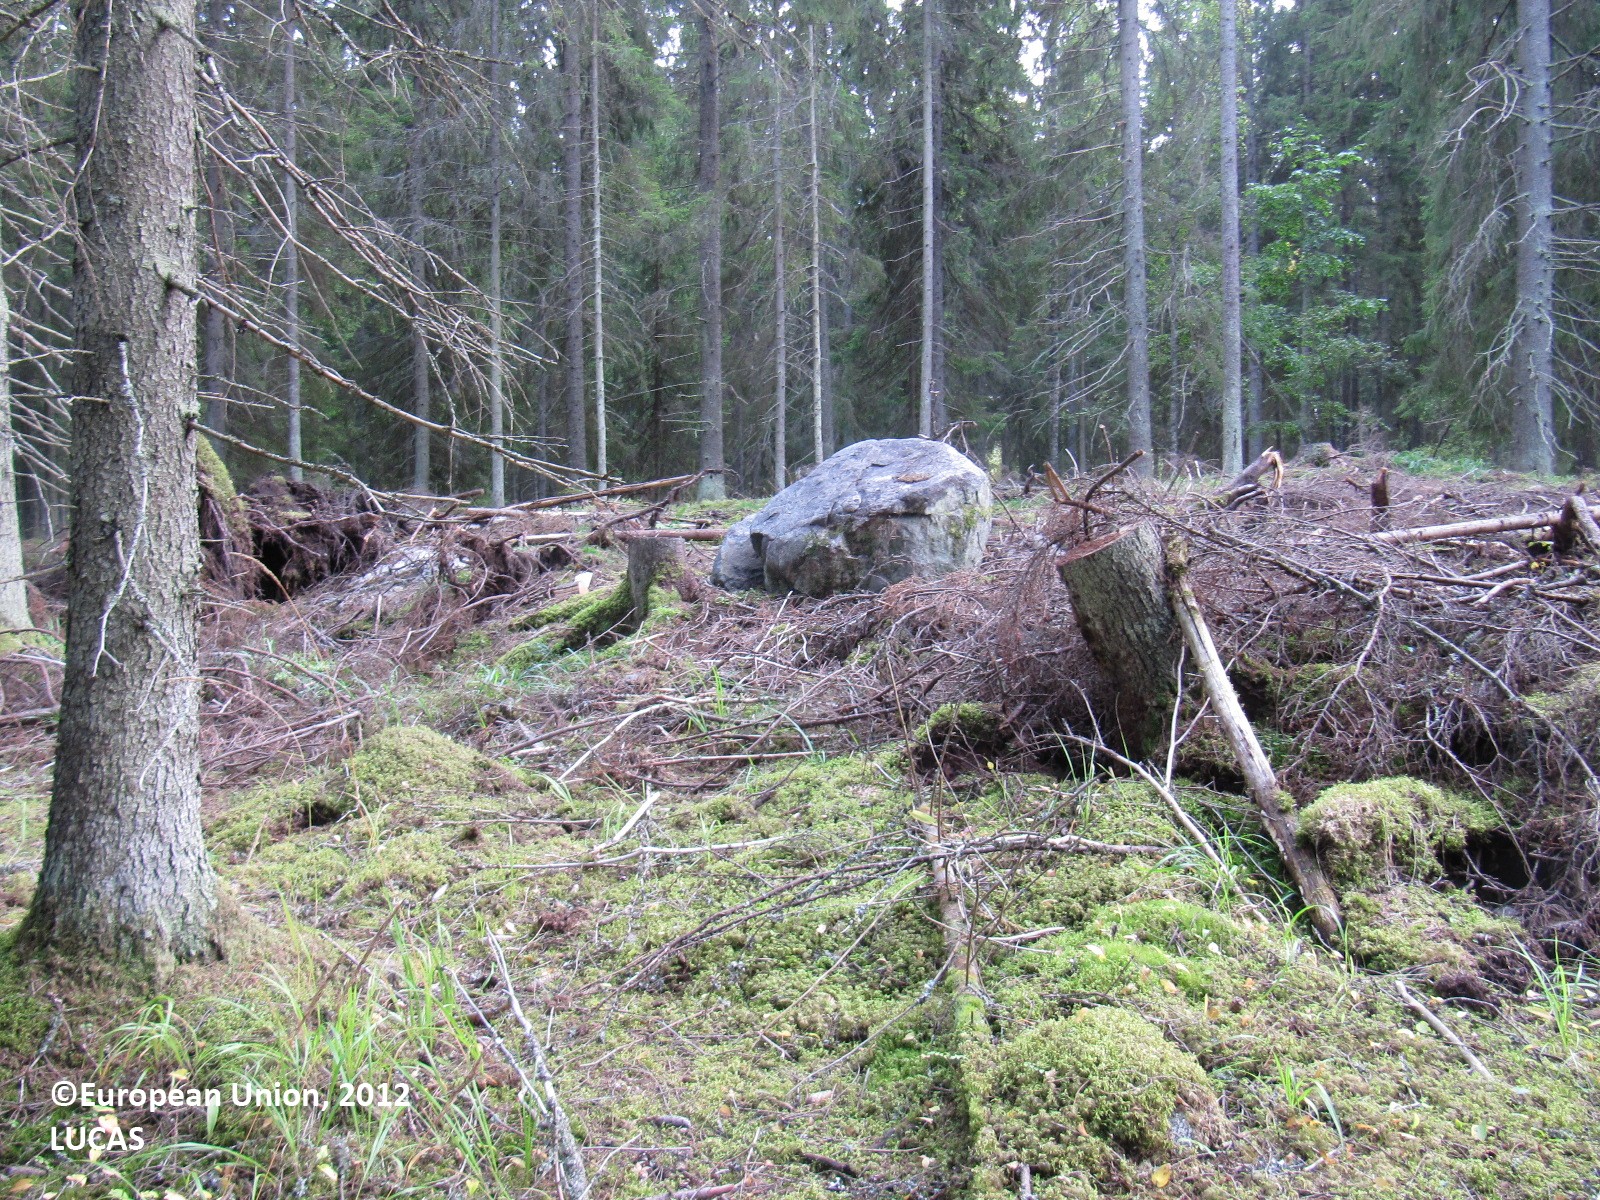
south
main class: Woodland
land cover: Spruce dominated coniferous woodland
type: boreal forest
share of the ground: > 75 %
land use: Forestry
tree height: > 5 m
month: August
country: FI
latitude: 61.0506
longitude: 22.8697
